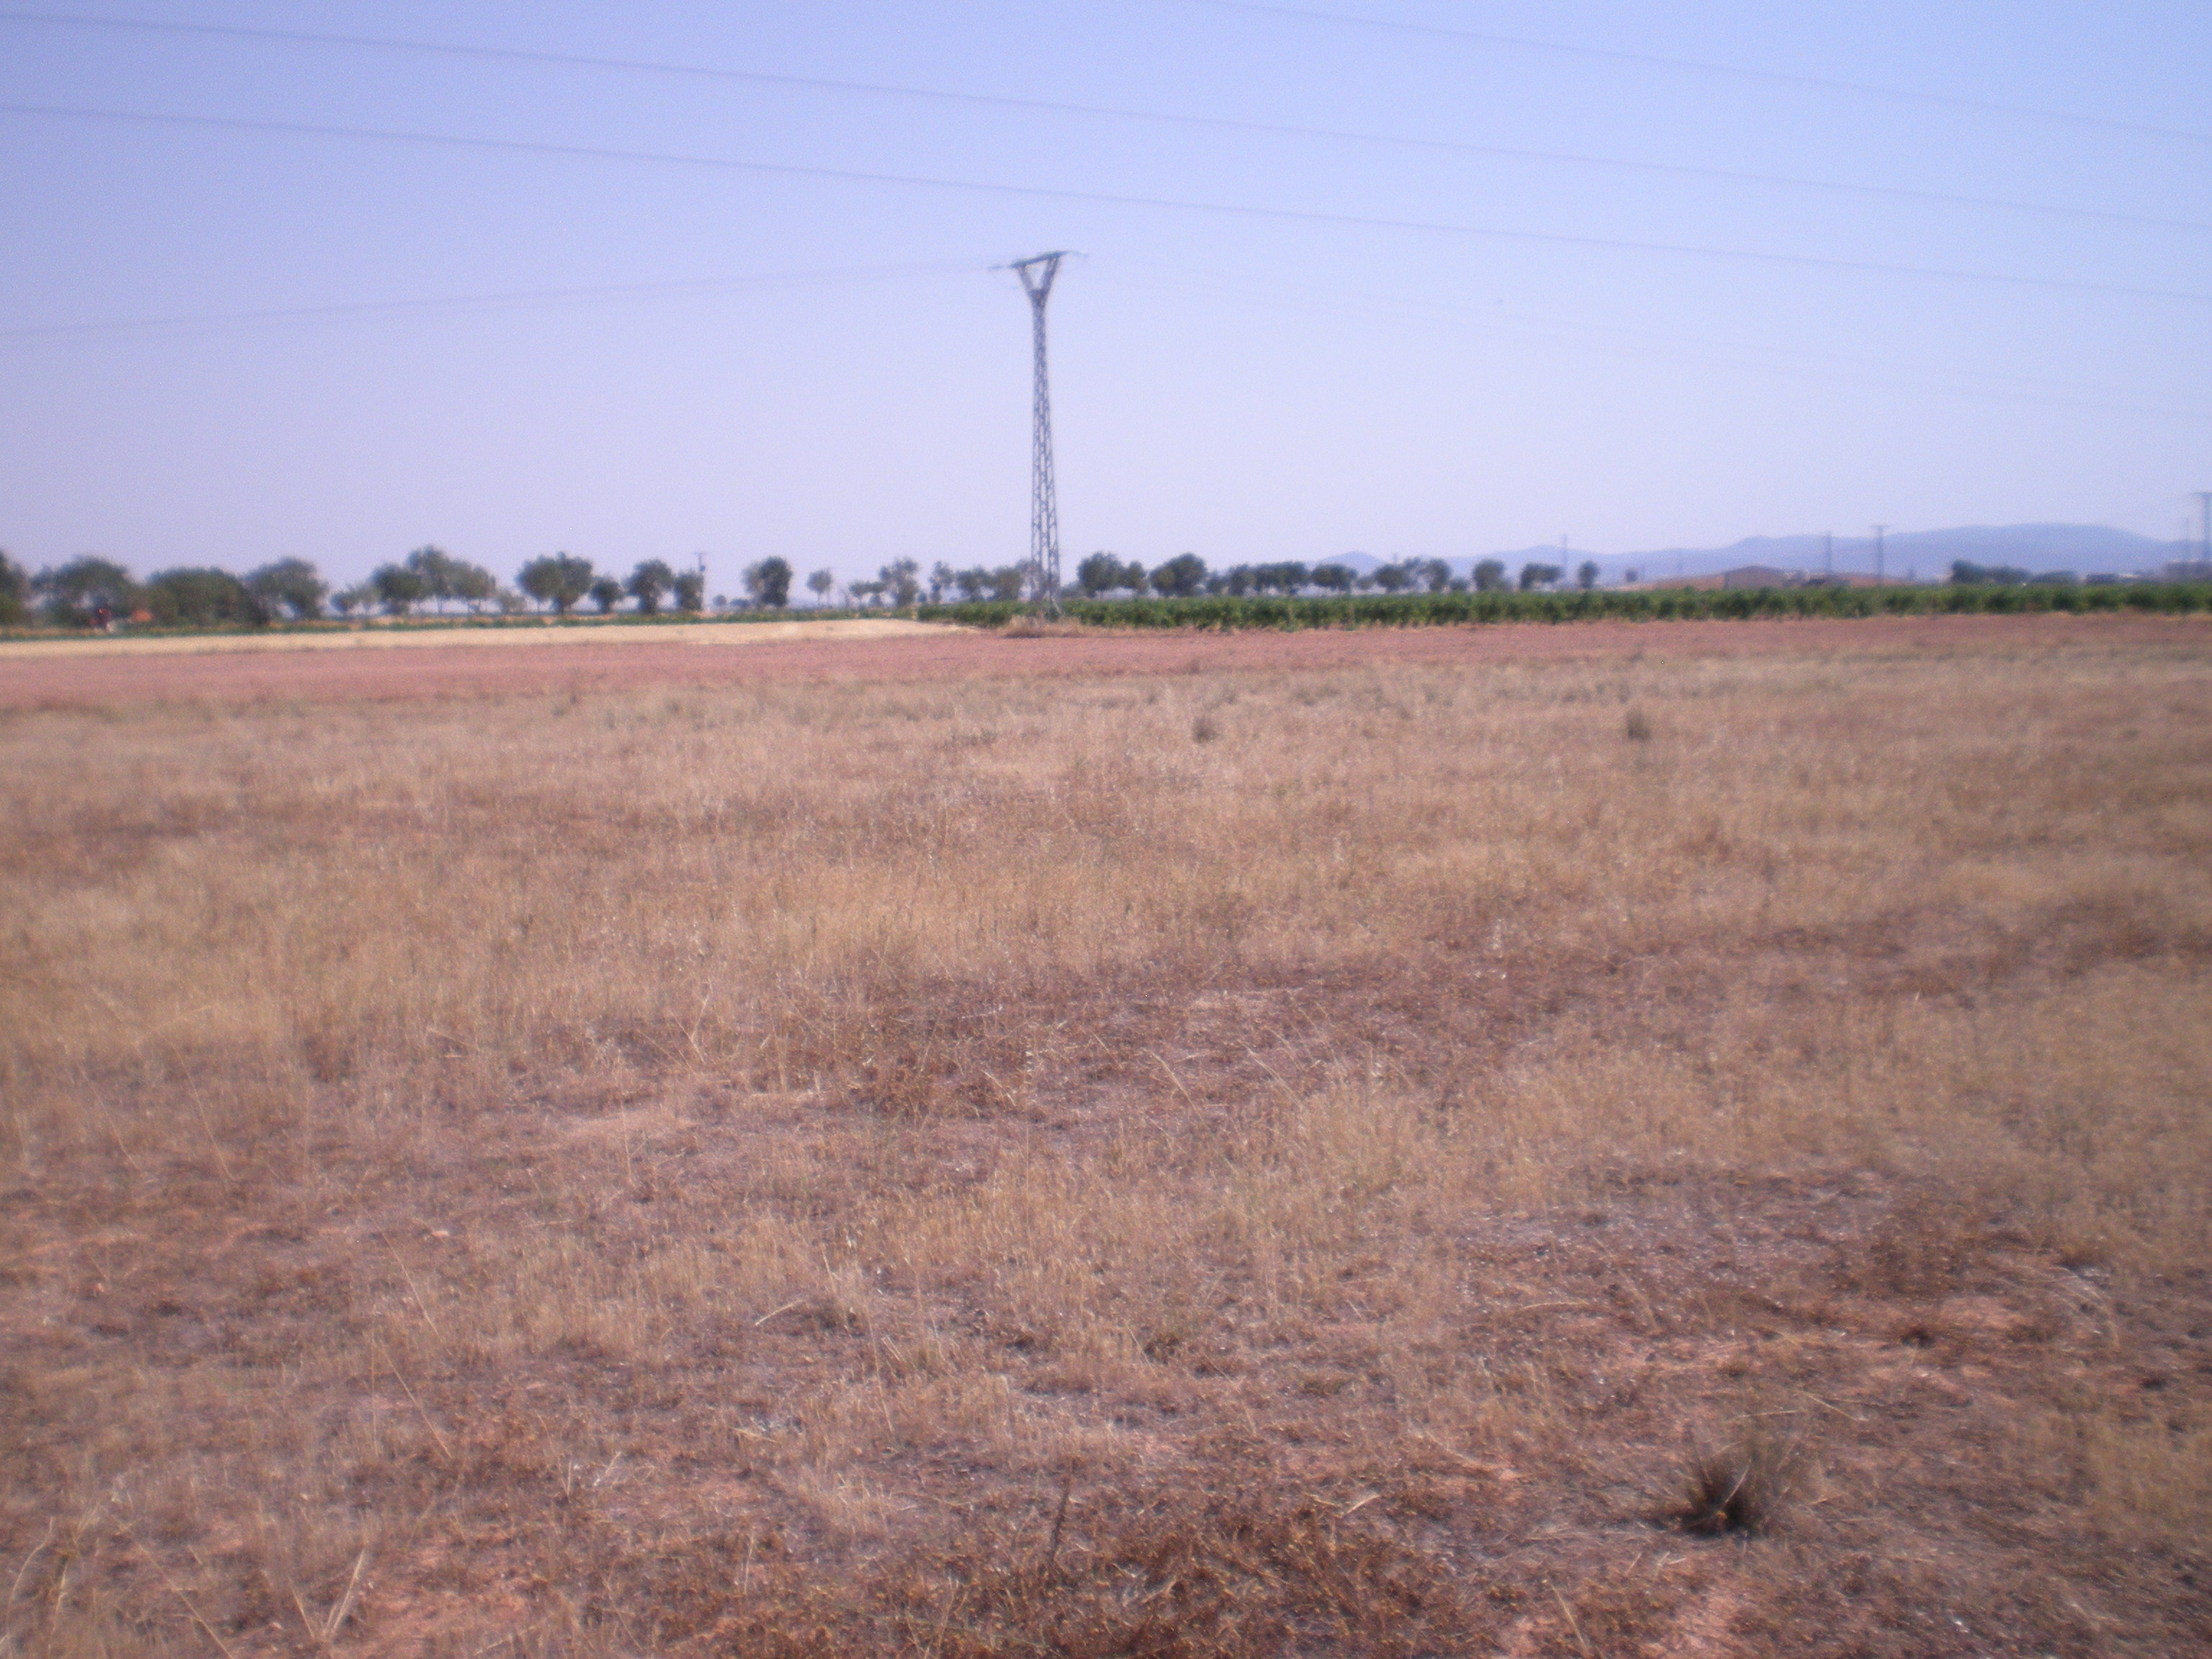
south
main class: Grassland
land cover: Spontaneously vegetated surfaces
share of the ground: 10 - 25 %
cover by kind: unconsolidated bare surface 80 %, herbaceous plants 20 %
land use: Agriculture (excluding fallow land and kitchen gardens)
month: July
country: ES
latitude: 39.4913
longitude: -3.5223
